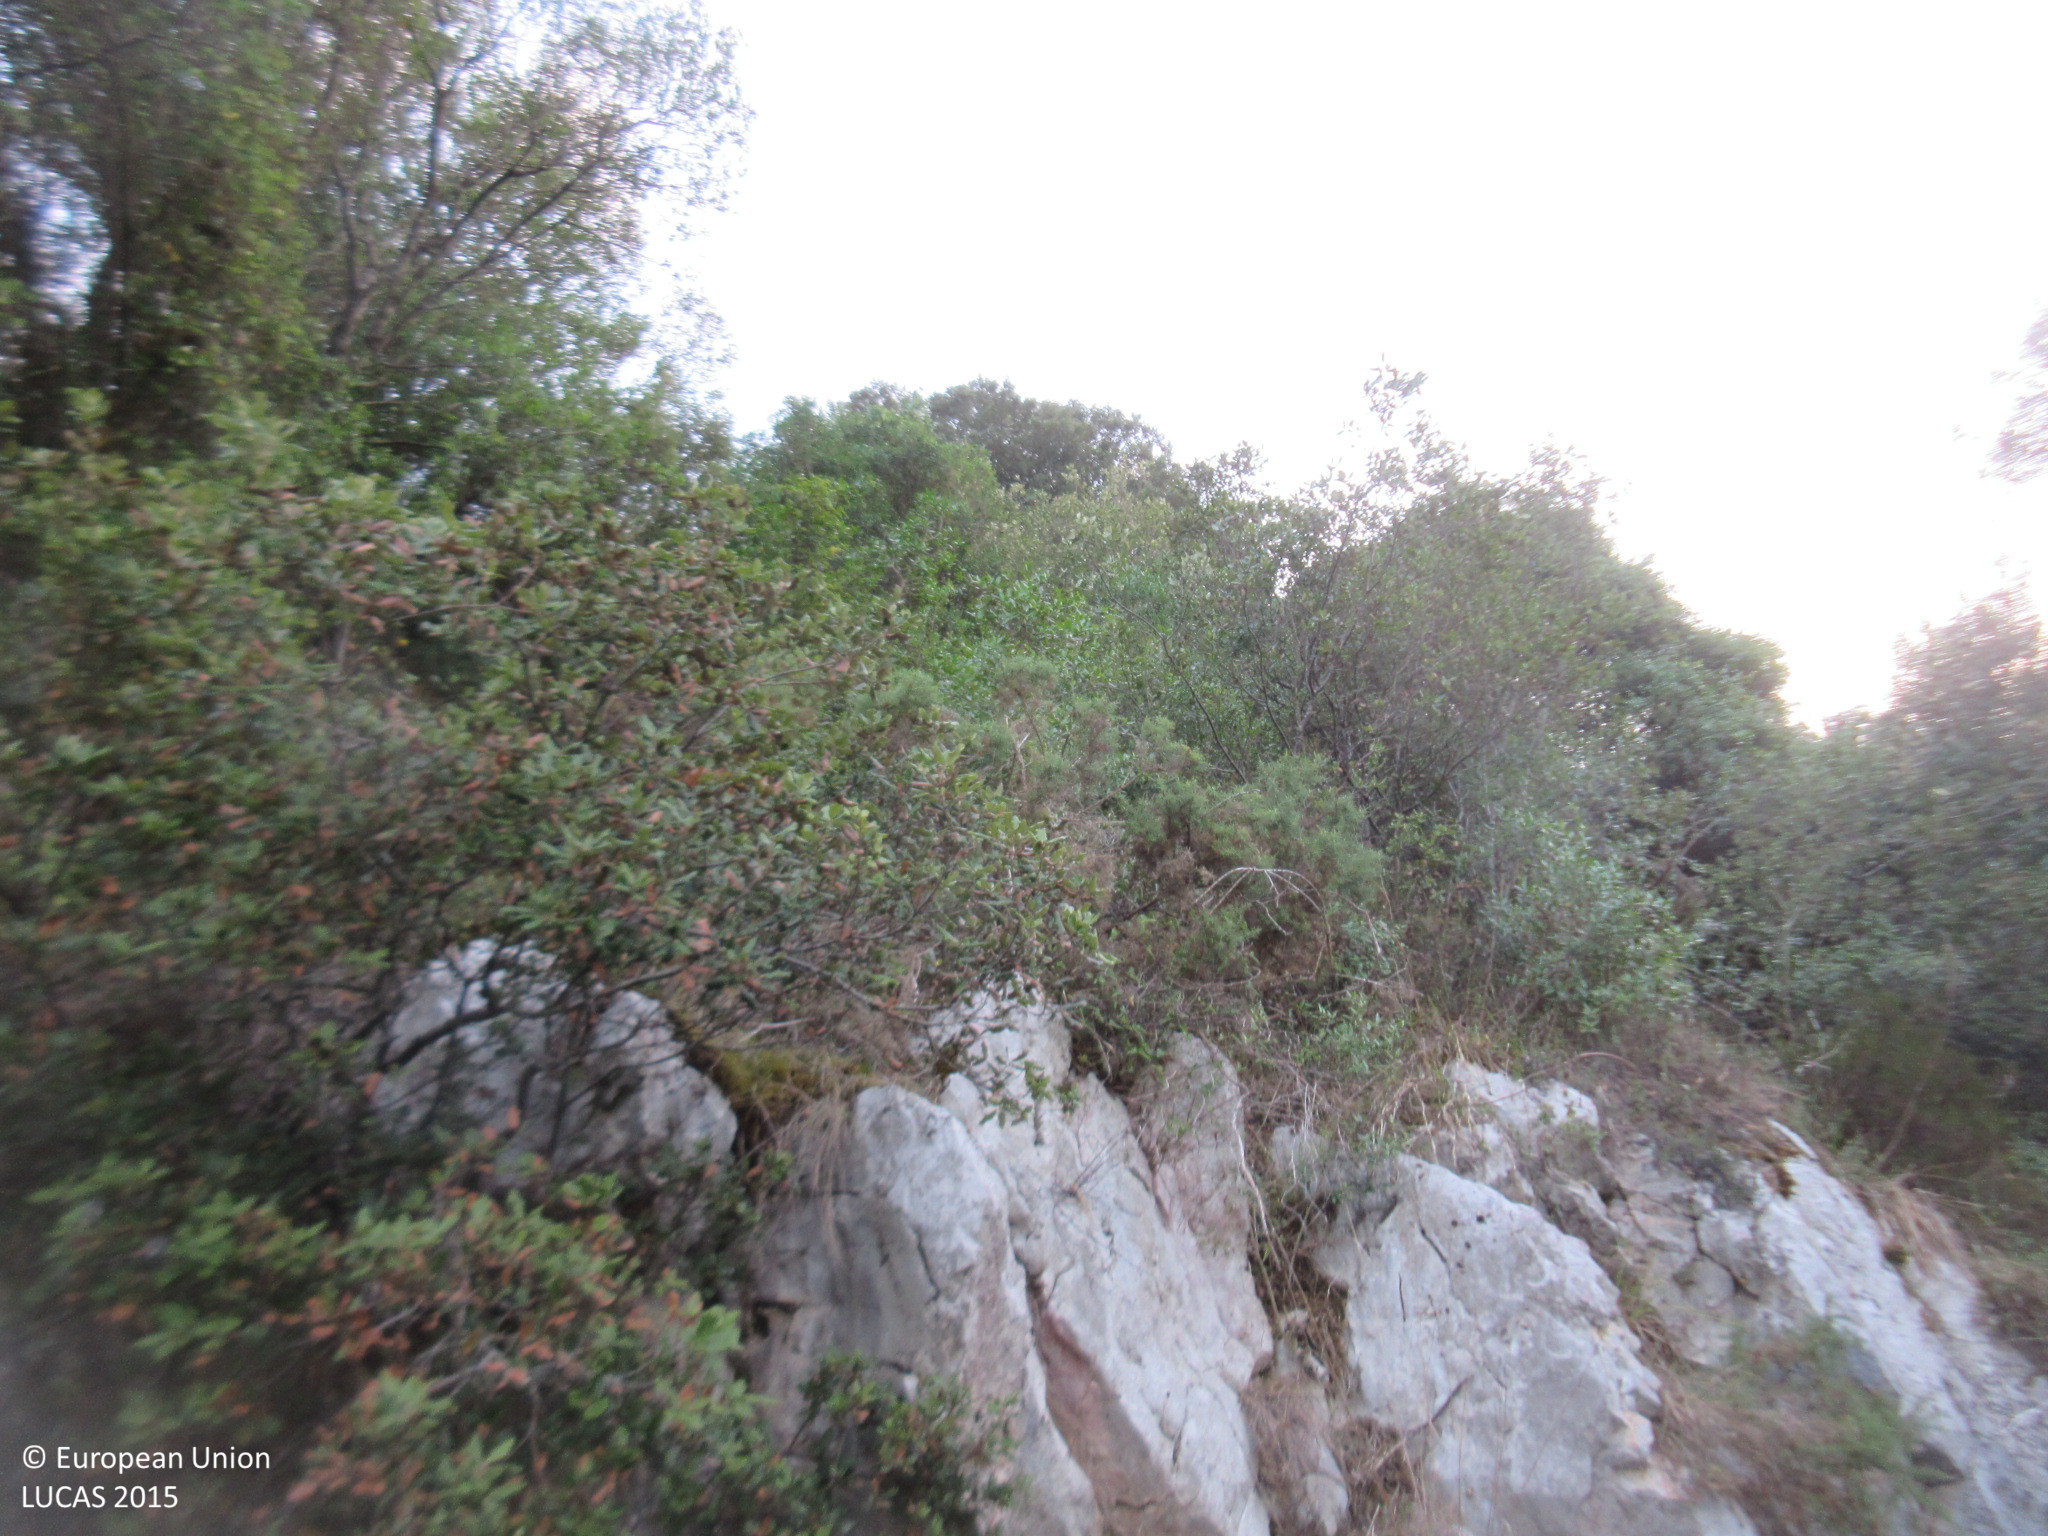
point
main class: Woodland
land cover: Broadleaved woodland
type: broadleaved evergreen forest
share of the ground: 50 - 75 %
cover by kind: broadleaved forest trees 70 %, shrubs 30 %
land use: Semi-natural and natural areas not in use
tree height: > 5 m
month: July
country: ES
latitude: 43.2911
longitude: -3.9652
